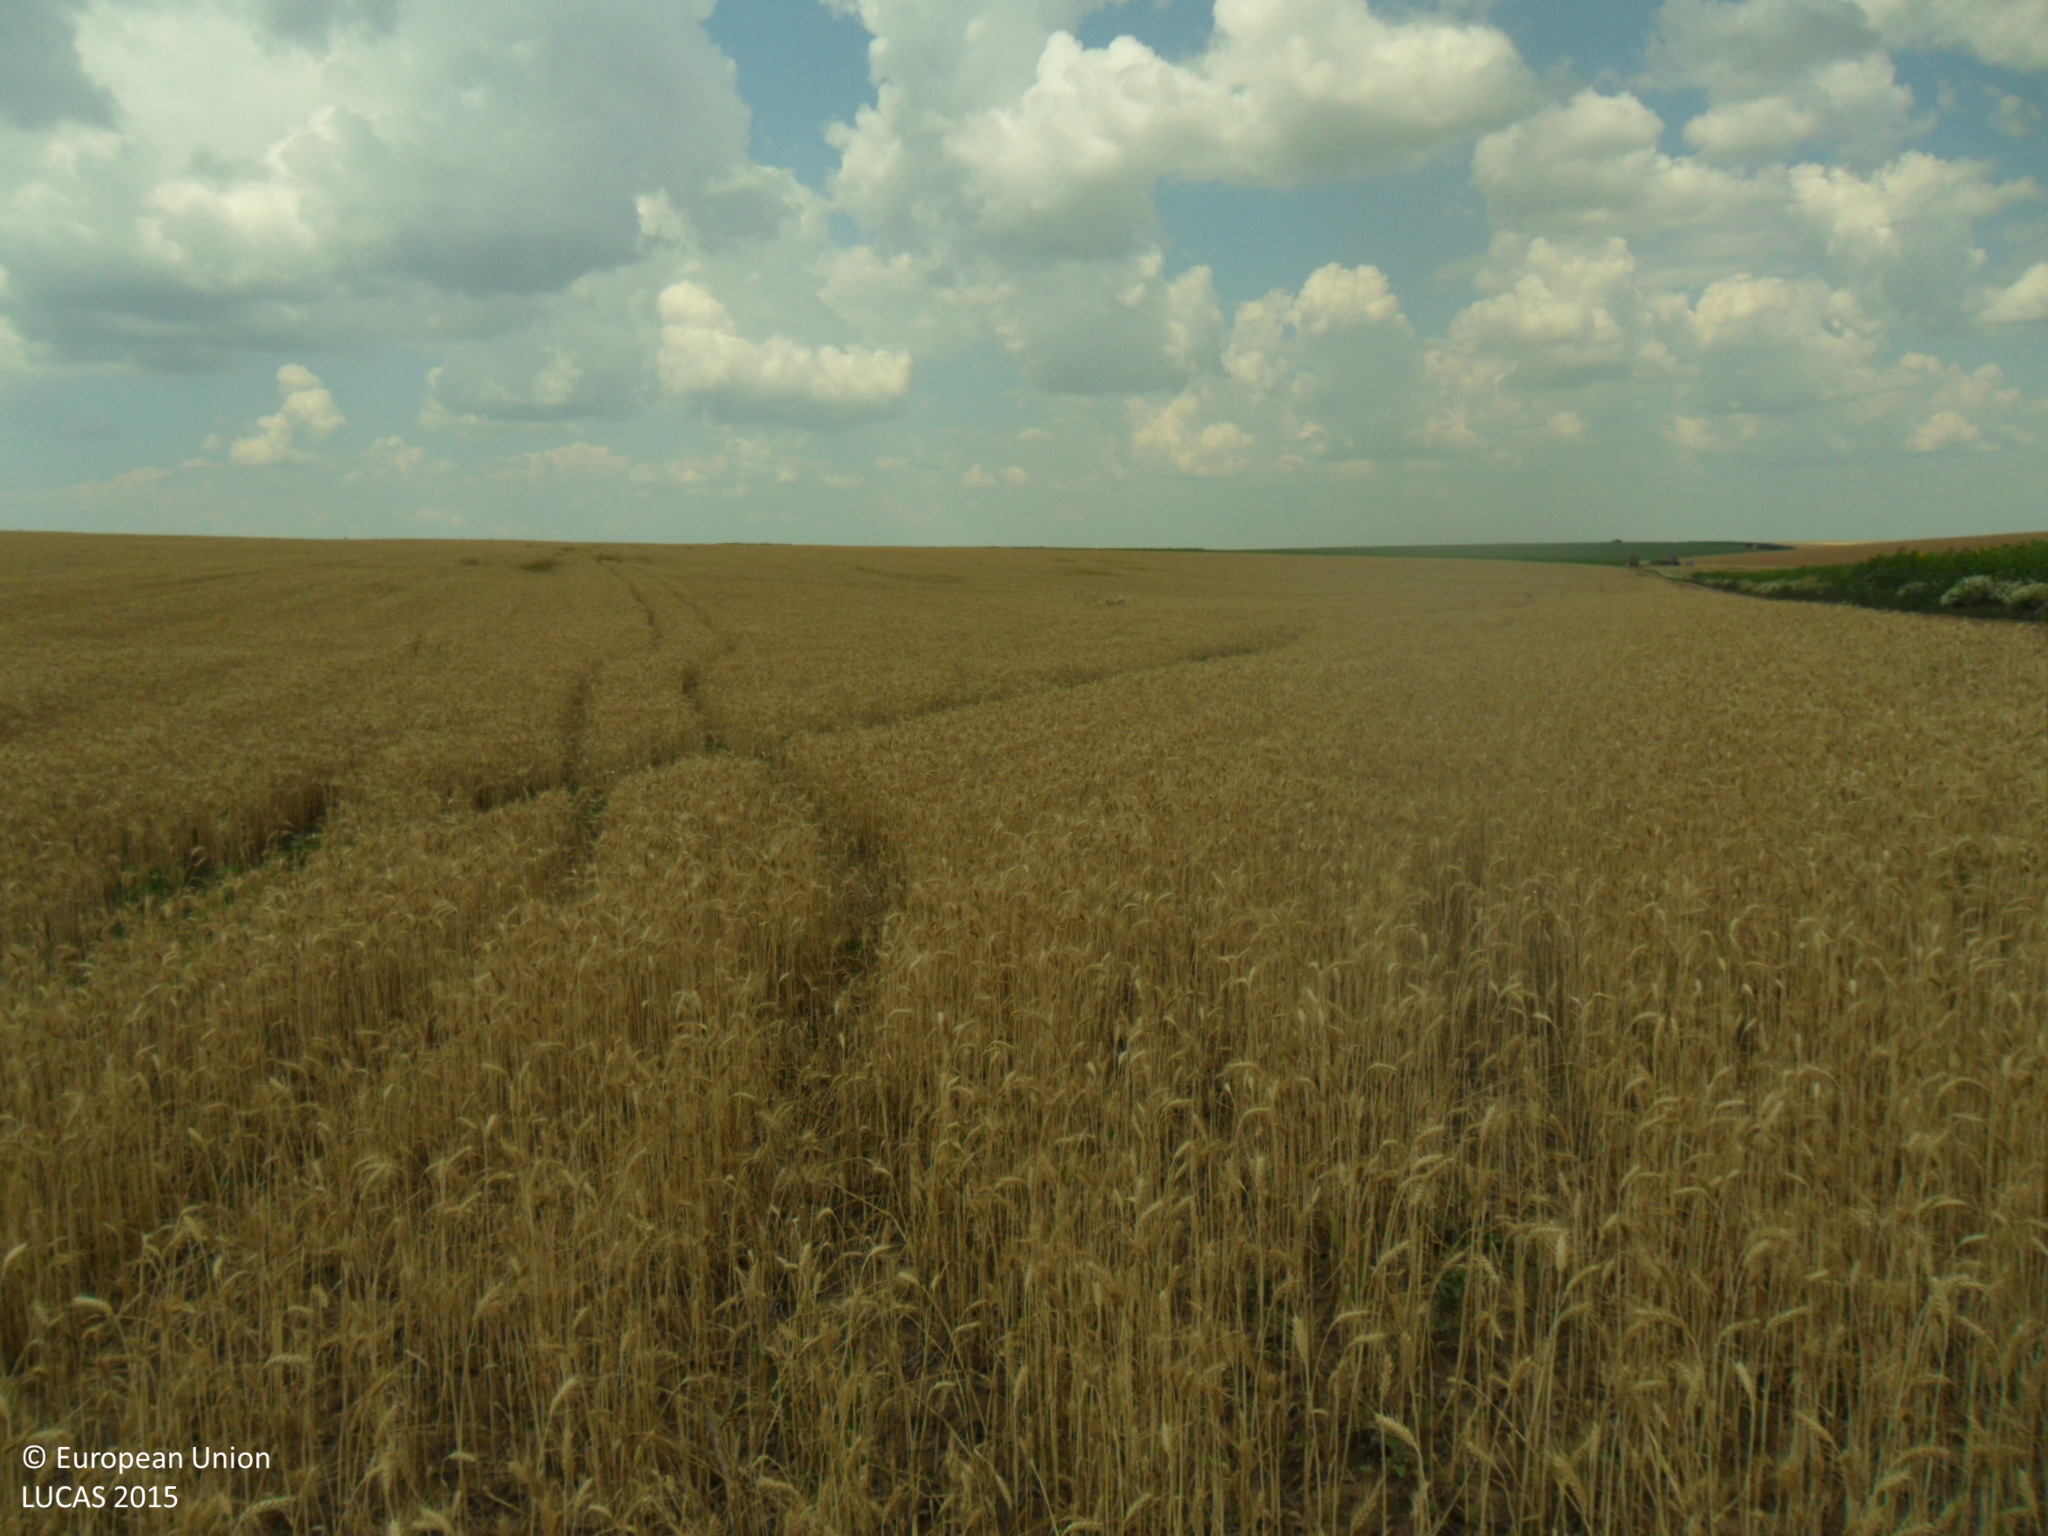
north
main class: Cropland
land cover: Common wheat
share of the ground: > 75 %
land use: Agriculture (excluding fallow land and kitchen gardens)
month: July
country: BG
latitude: 43.6431
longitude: 26.8382
